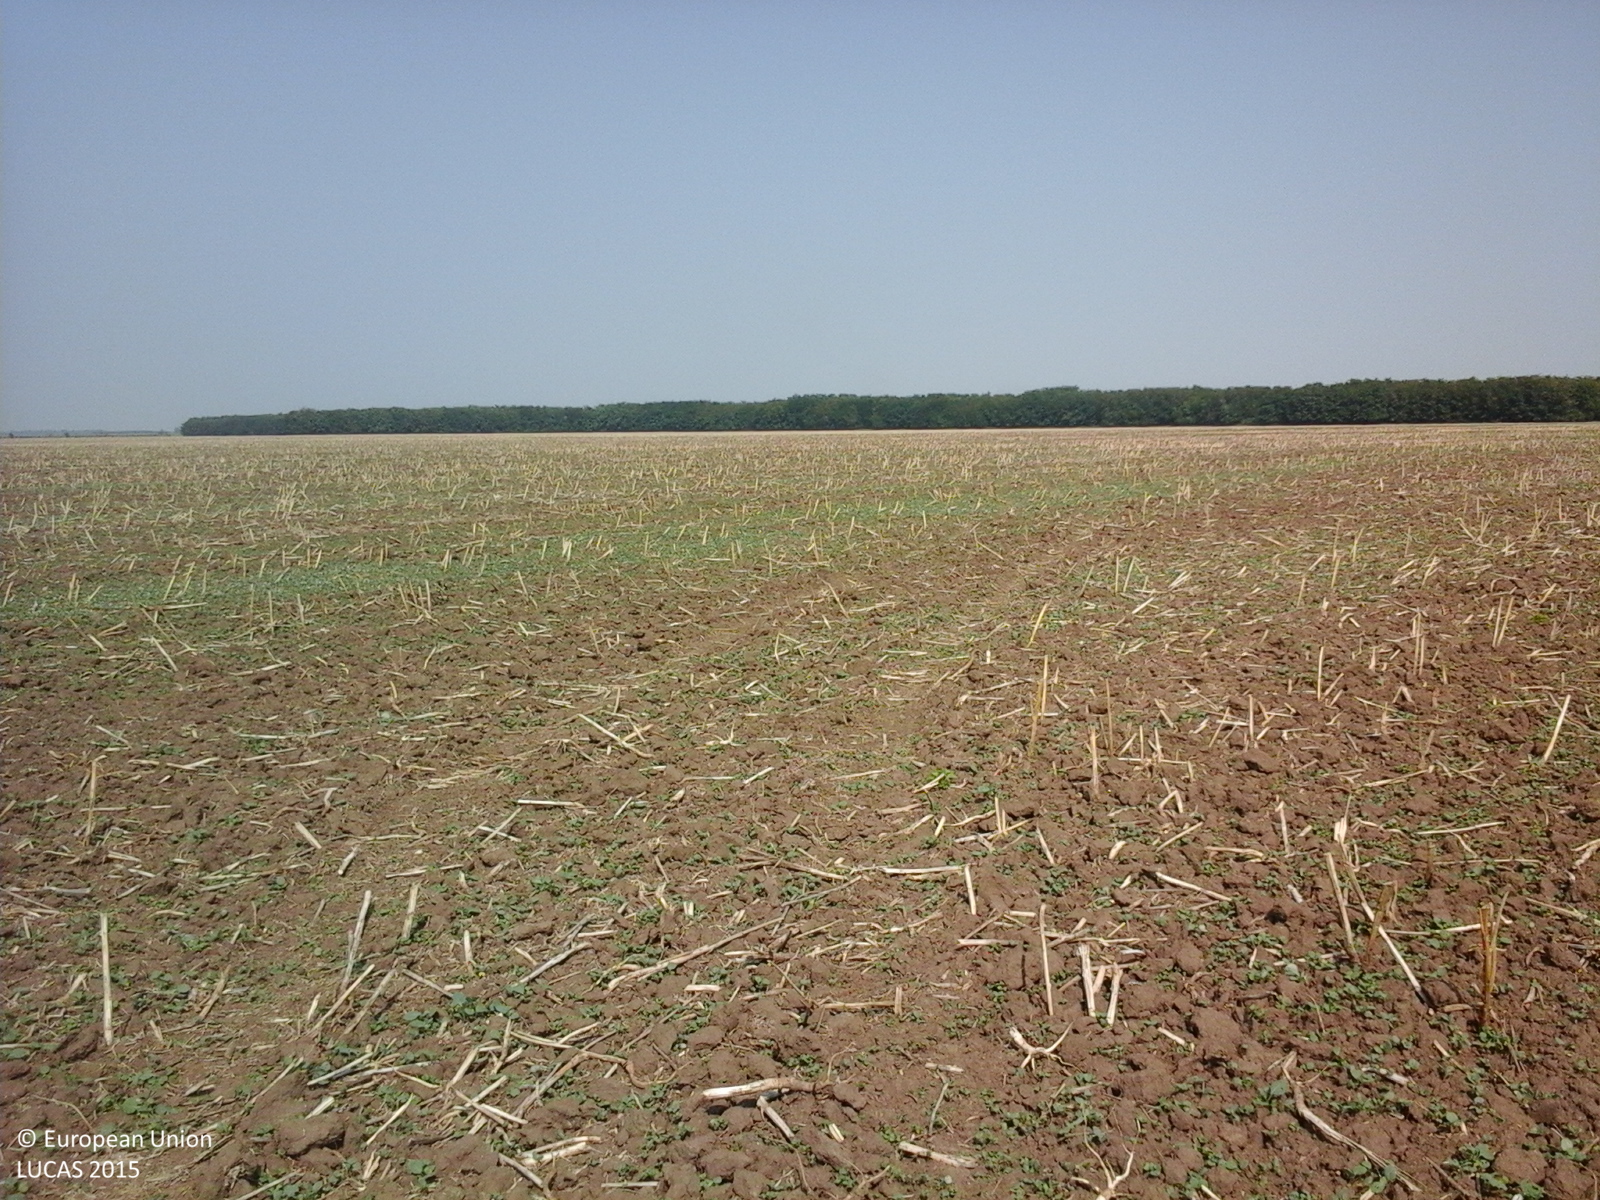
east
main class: Cropland
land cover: Rape and turnip rape
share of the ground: < 10 %
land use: Agriculture (excluding fallow land and kitchen gardens)
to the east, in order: Rape and turnip rape
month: July
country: RO
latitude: 44.5630
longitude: 26.4965
